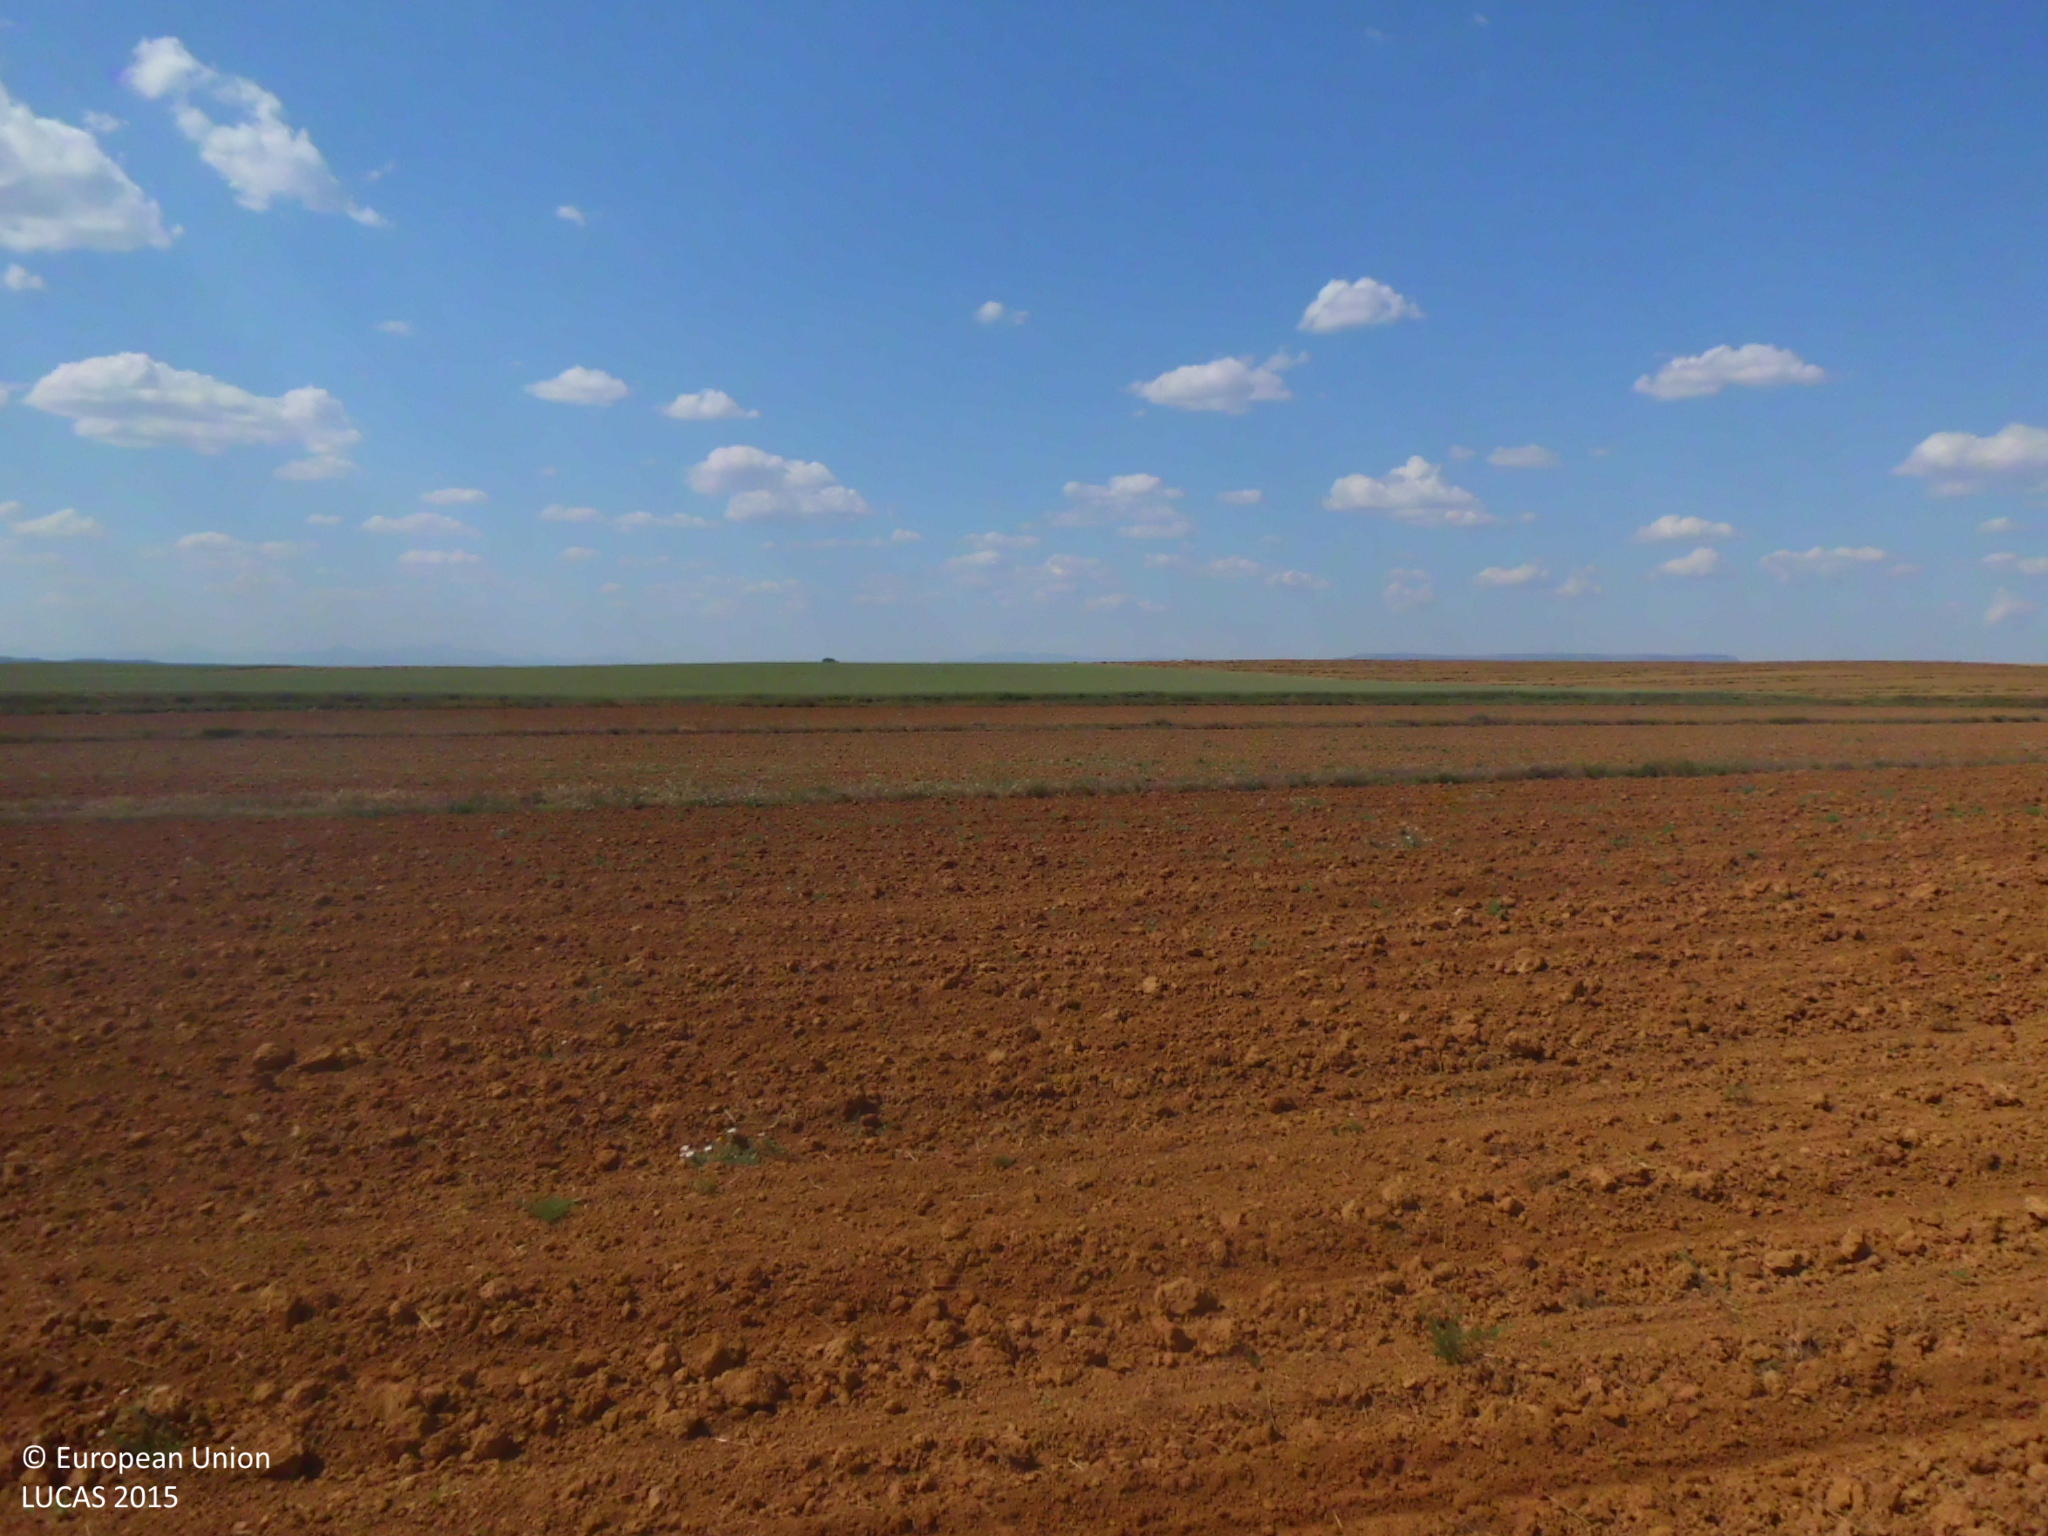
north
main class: Cropland
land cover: Sunflower
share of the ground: < 10 %
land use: Agriculture (excluding fallow land and kitchen gardens)
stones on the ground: < 10 %
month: June
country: ES
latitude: 42.4340
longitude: -4.2068
